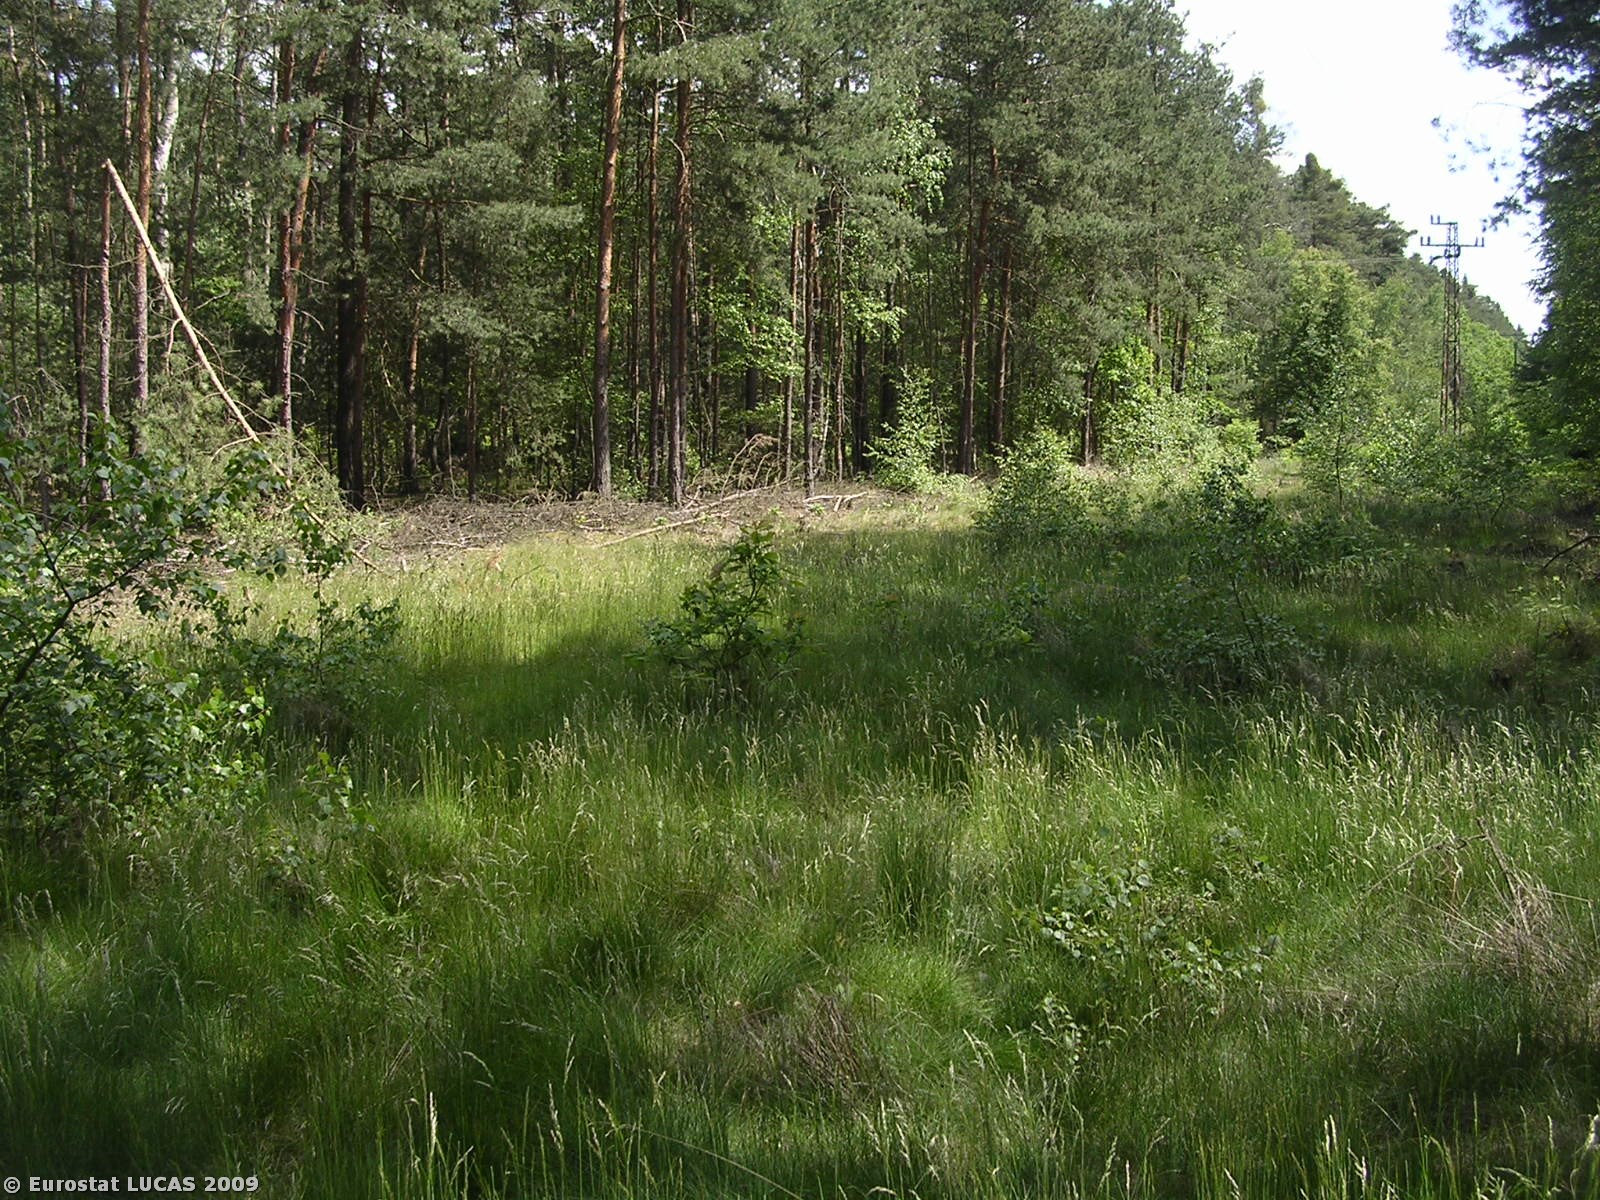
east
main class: Grassland
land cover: Grassland with sparse tree/shrub cover
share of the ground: > 75 %
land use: Forestry
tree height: > 5 m
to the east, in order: Grassland with sparse tree/shrub cover; Electric lines; Grassland with sparse tree/shrub cover; Coniferous woodland; Tracks; Grassland with sparse tree/shrub cover; Electric lines; Grassland with sparse tree/shrub cover; Coniferous woodland; Tracks; Coniferous woodland; Mixed woodland
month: May
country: CZ
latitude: 50.2315
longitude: 14.6984
